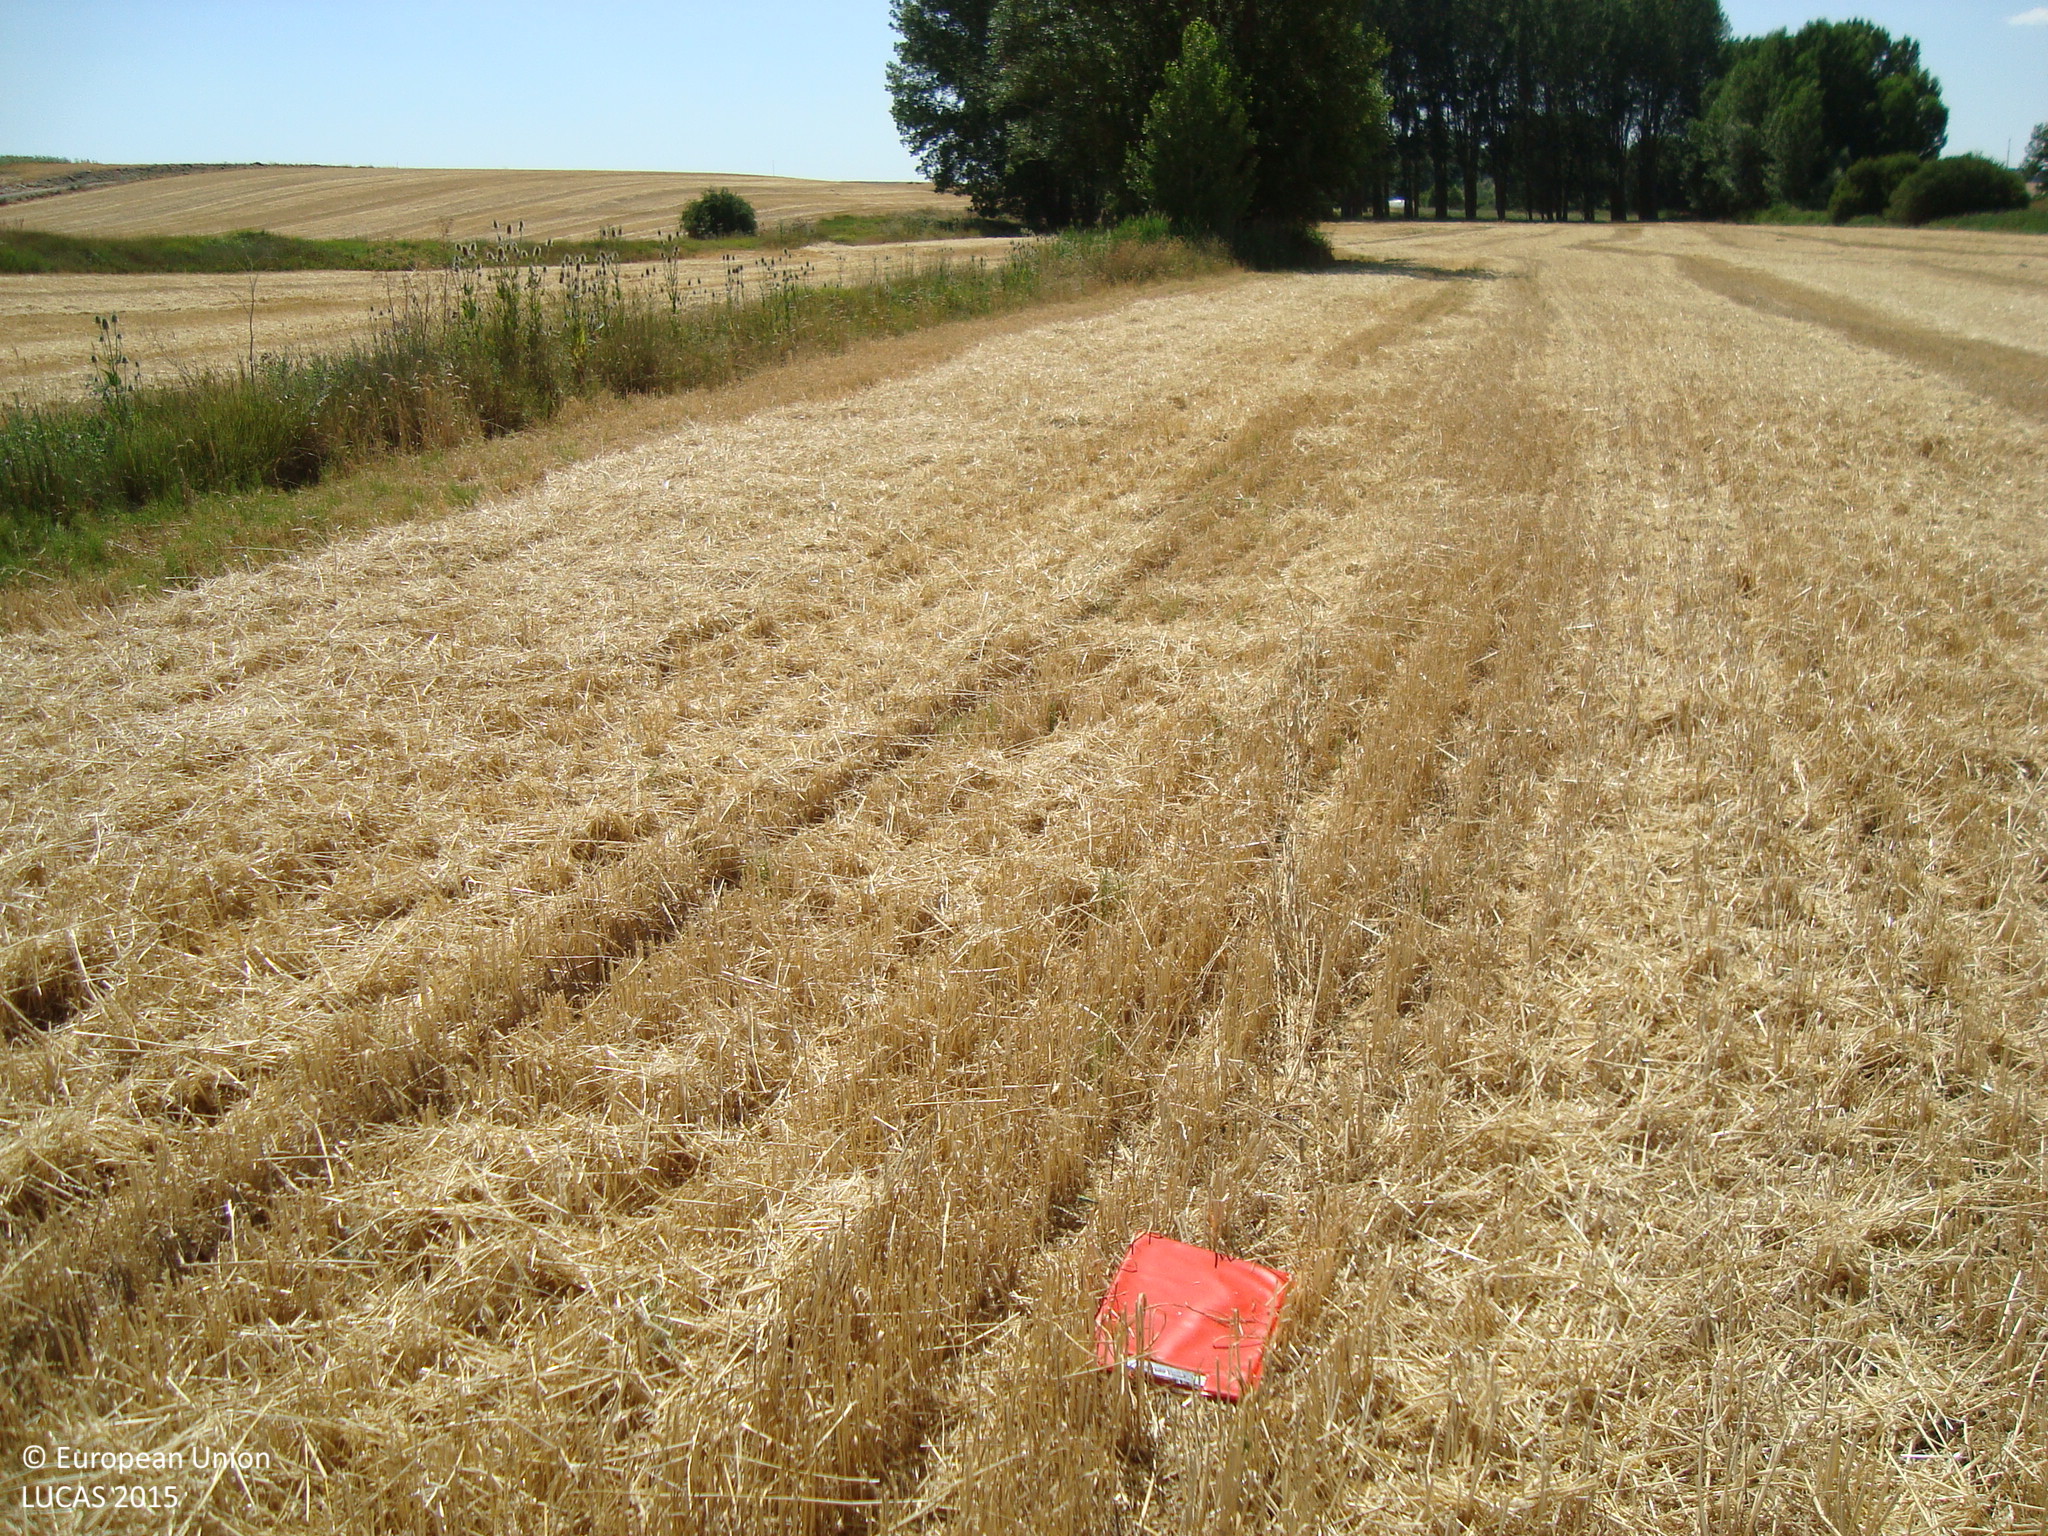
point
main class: Cropland
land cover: Common wheat
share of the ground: > 75 %
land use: Agriculture (excluding fallow land and kitchen gardens)
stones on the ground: < 10 %
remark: Harvested field
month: July
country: ES
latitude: 41.8639
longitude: -3.7047
